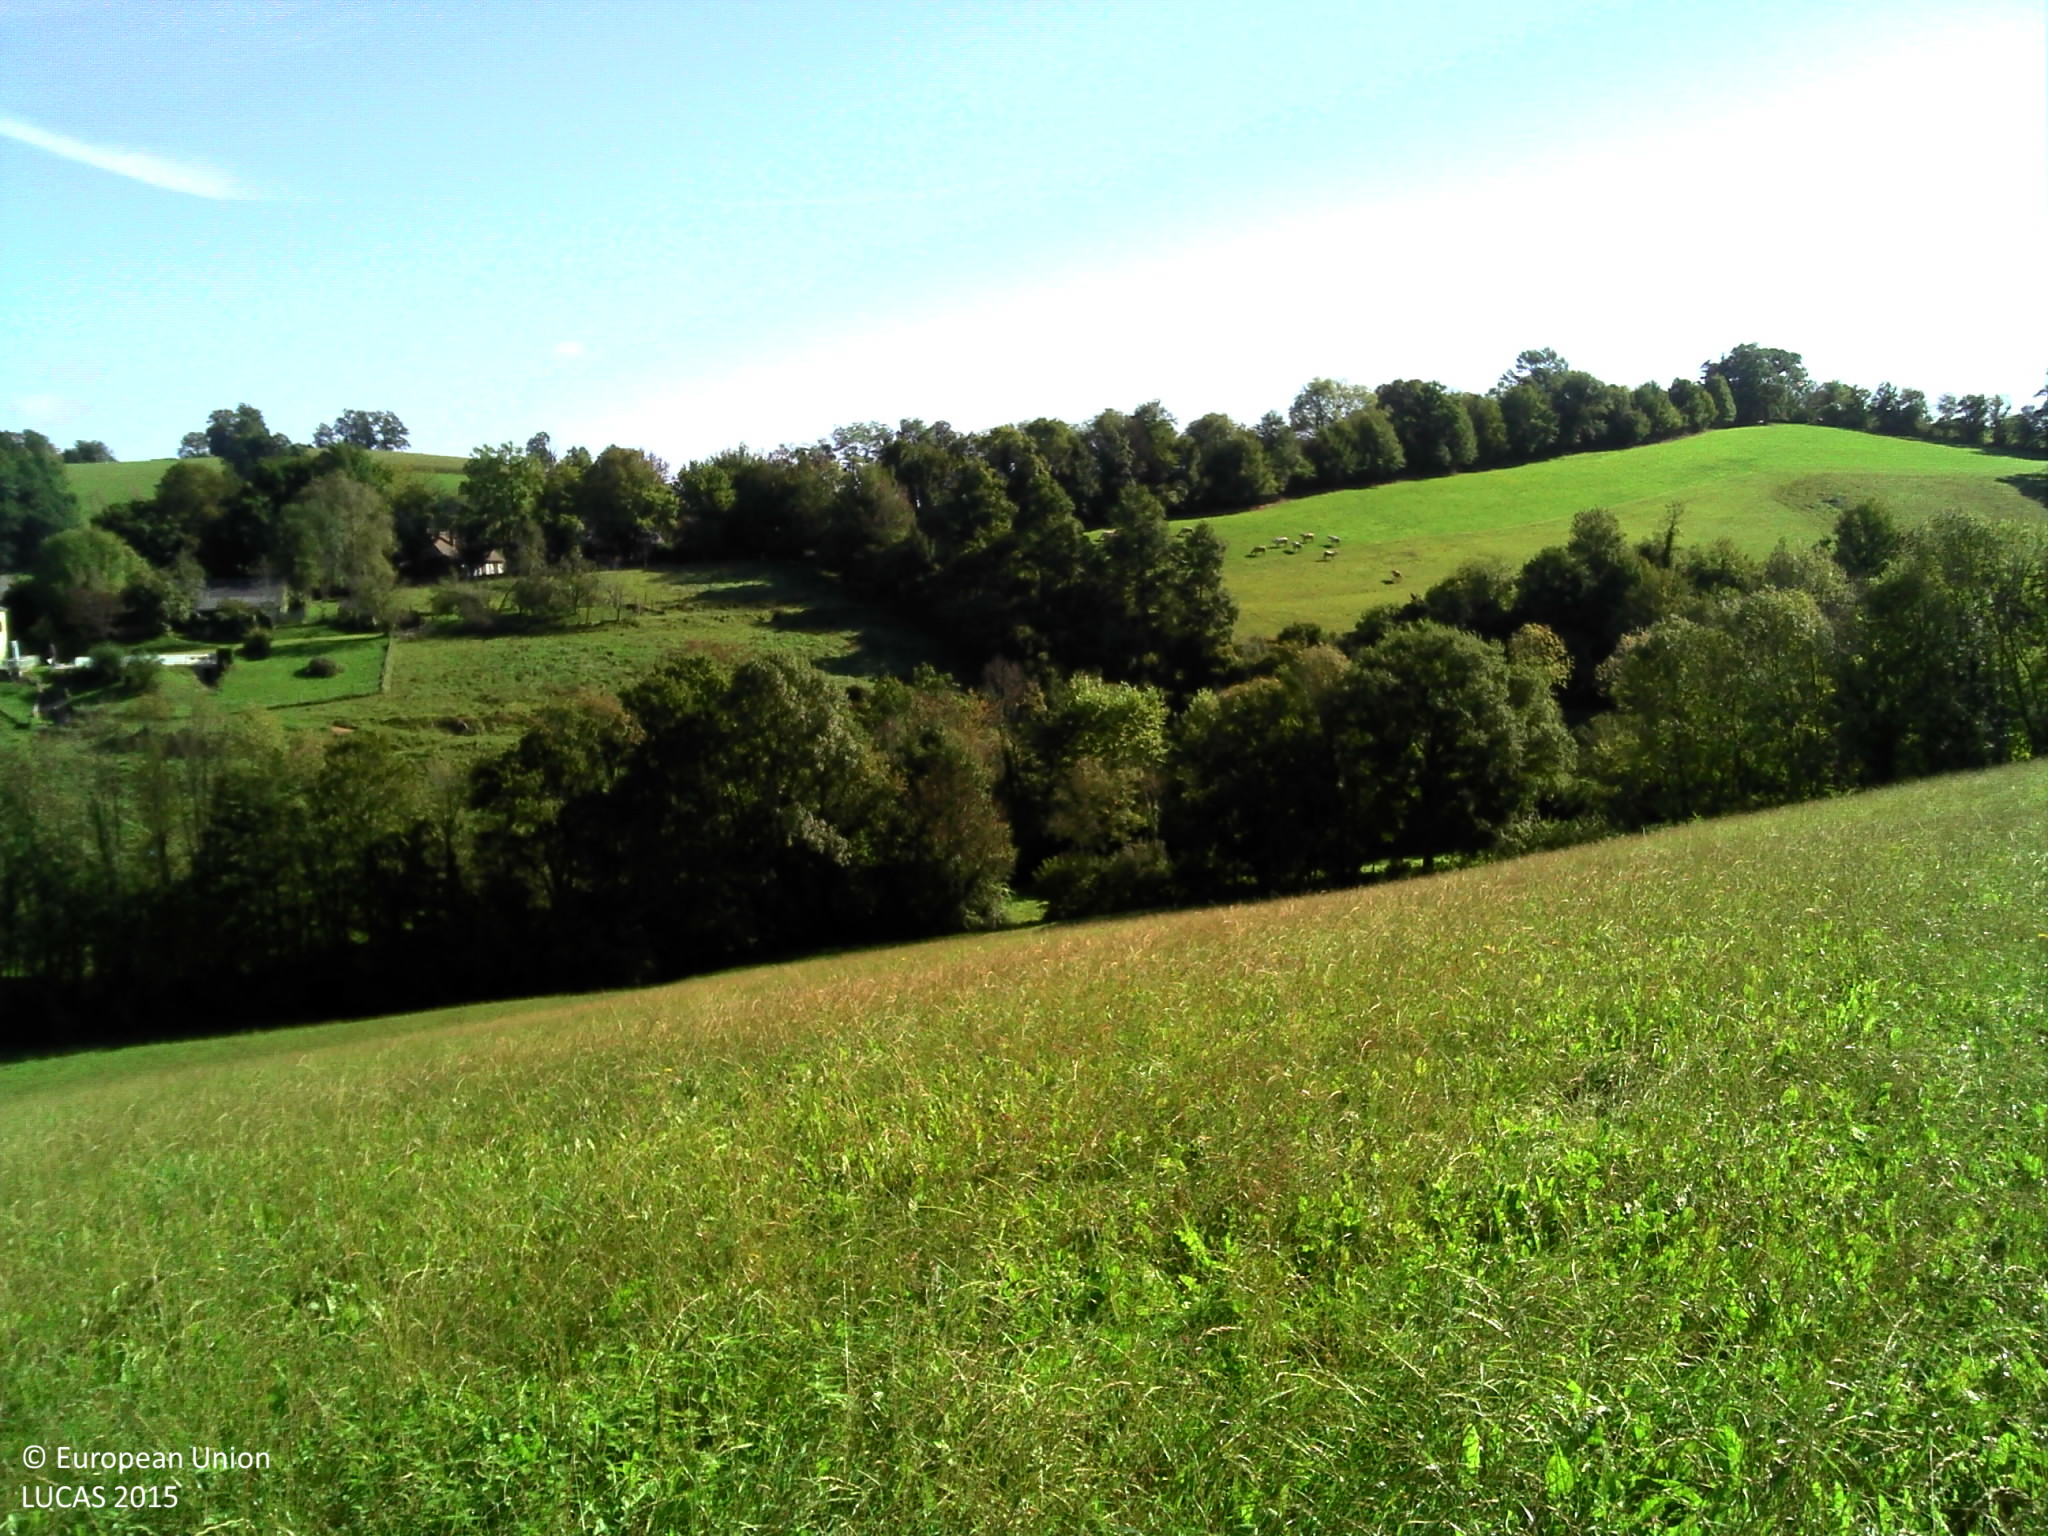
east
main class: Grassland
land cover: Grassland without tree/shrub cover
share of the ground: > 75 %
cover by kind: herbaceous plants 100 %
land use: Agriculture (excluding fallow land and kitchen gardens)
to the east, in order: Grassland without tree/shrub cover; Abandoned hedges; Rivers and streams; Broadleaved woodland; Grassland without tree/shrub cover; Fences; Broadleaved woodland; Rivers and streams; Abandoned hedges; Fences; Grassland with sparse tree/shrub cover; Broadleaved woodland
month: September
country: FR
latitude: 43.1543
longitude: -0.3974
